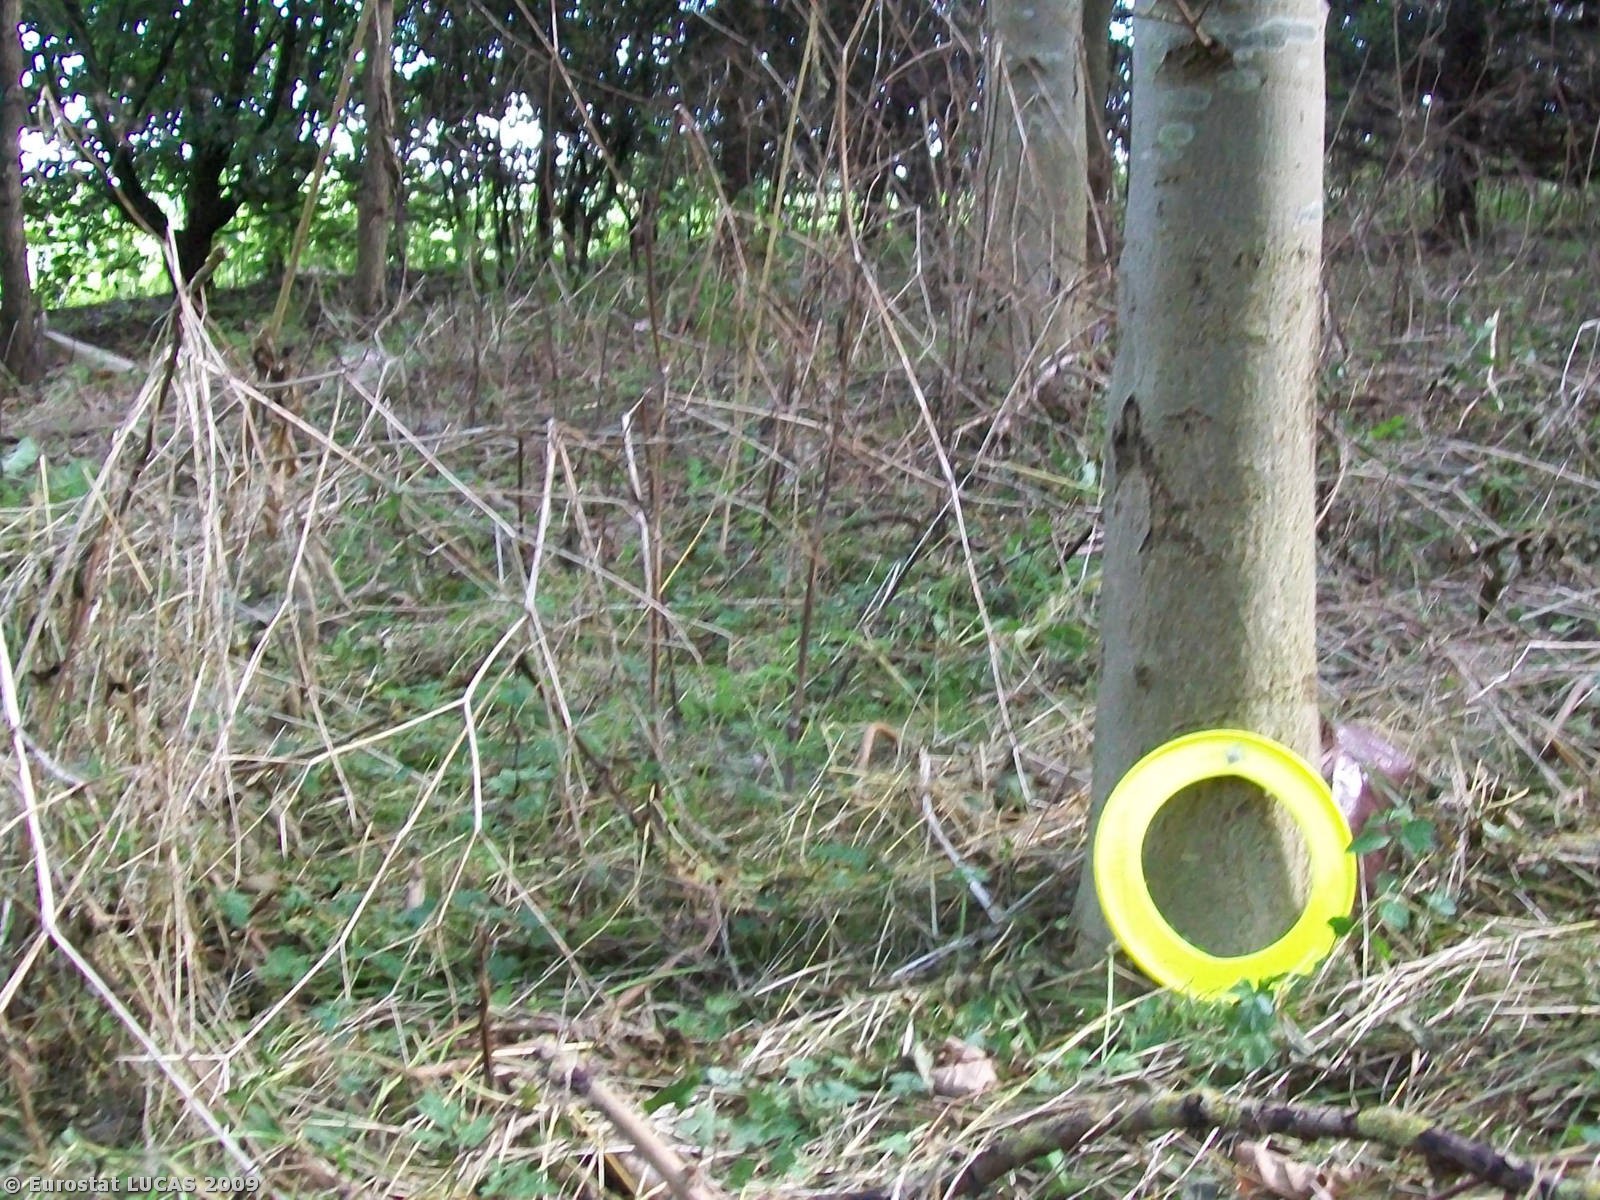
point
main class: Woodland
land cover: Broadleaved woodland
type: mesophytic deciduous forest
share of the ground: > 75 %
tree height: > 5 m
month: August
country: GB
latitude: 52.4927
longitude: -1.0767
